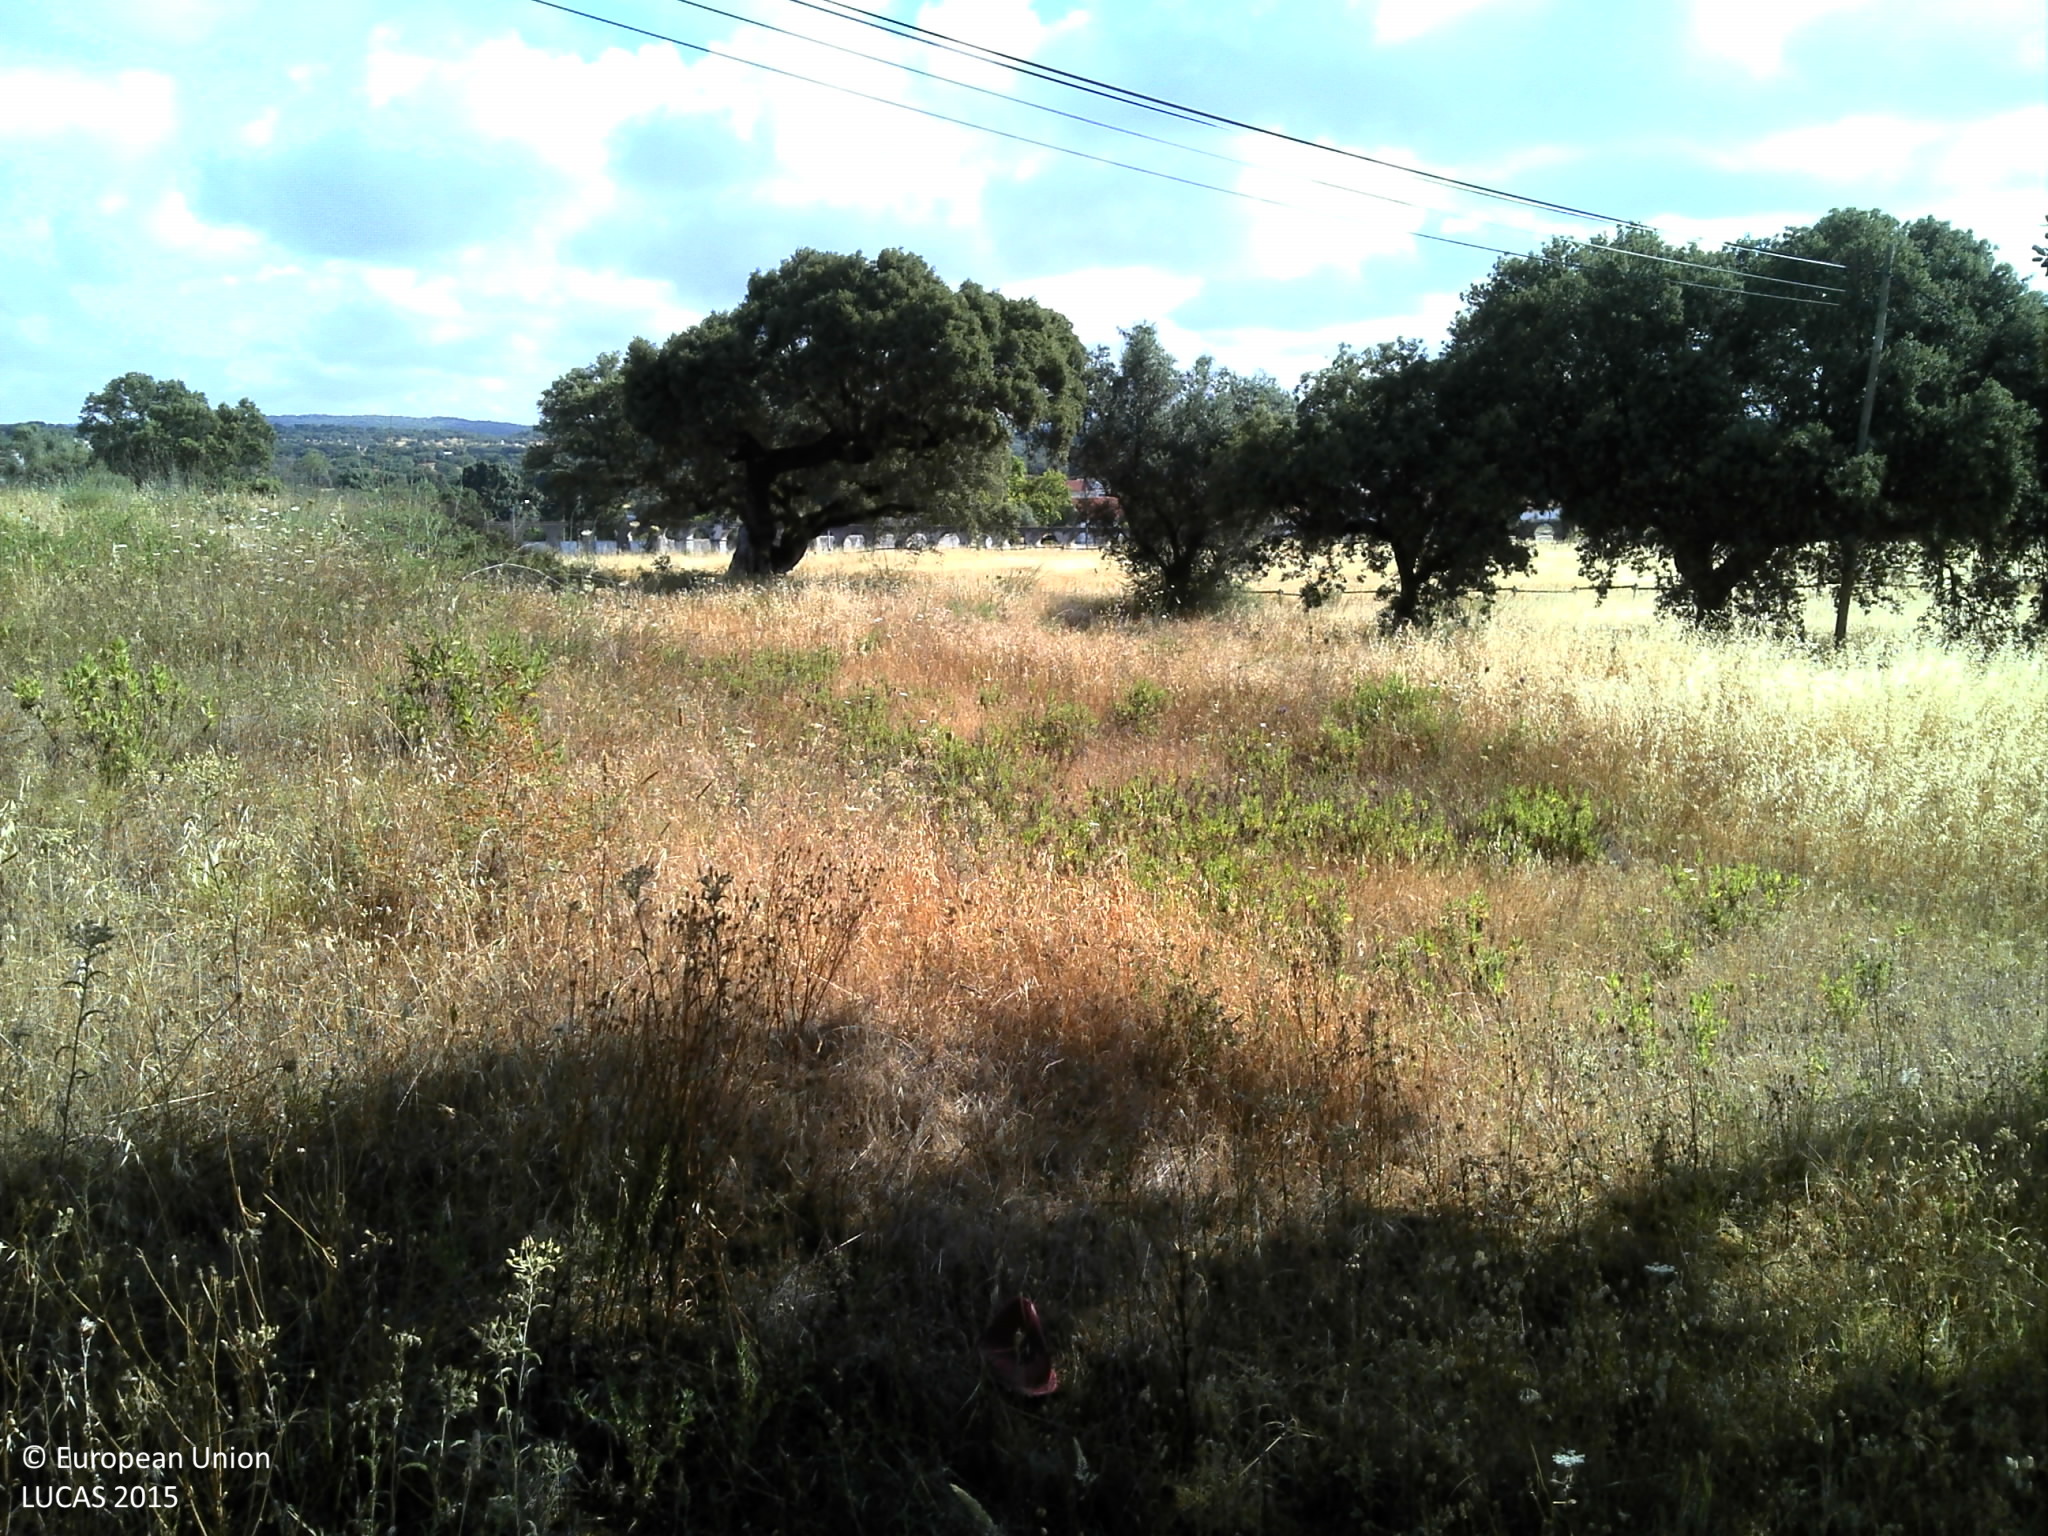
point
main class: Woodland
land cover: Broadleaved woodland
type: broadleaved evergreen forest
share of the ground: 25 - 50 %
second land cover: Grassland without tree/shrub cover
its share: 50 - 75 %
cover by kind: broadleaved forest trees 50 %, herbaceous plants 50 %
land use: Forestry
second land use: Agriculture (excluding fallow land and kitchen gardens)
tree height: > 5 m
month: June
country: PT
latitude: 38.5284
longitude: -8.0162
